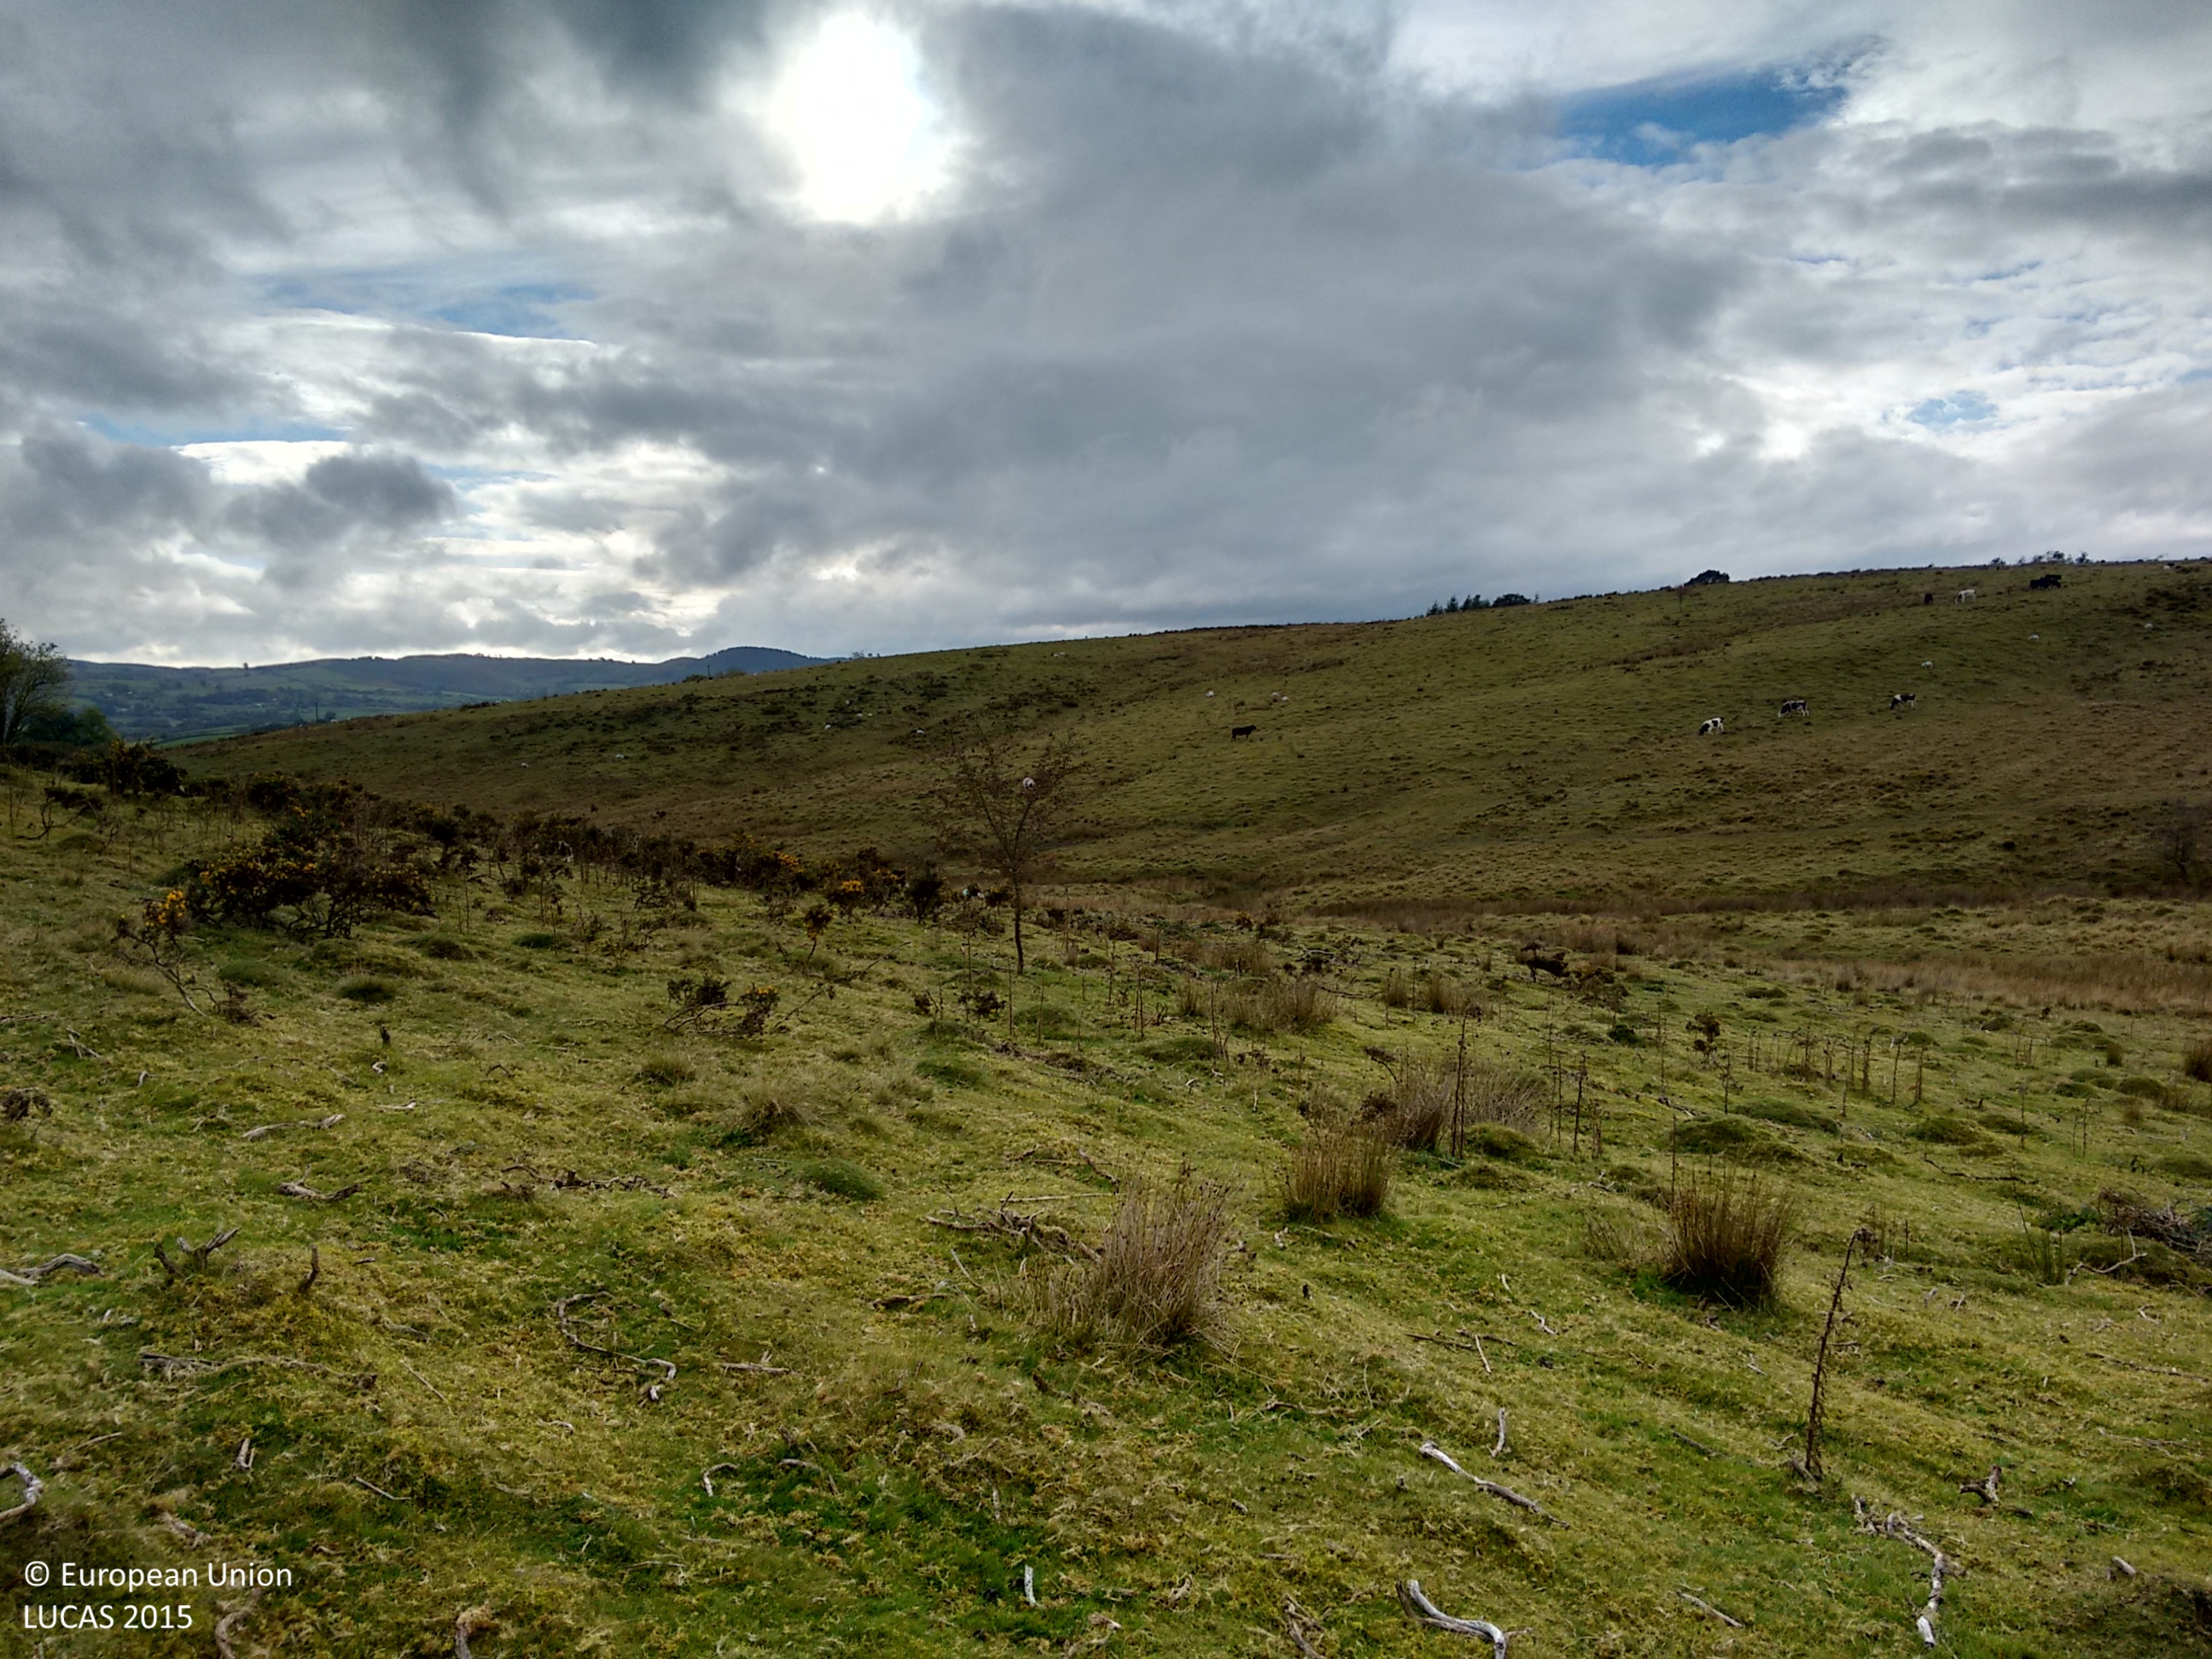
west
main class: Grassland
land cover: Grassland without tree/shrub cover
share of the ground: > 75 %
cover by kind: herbaceous plants 90 %, shrubs 5 %, lichens and mosses 5 %
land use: Agriculture (excluding fallow land and kitchen gardens)
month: October
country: GB
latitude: 52.2649
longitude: -3.2823
